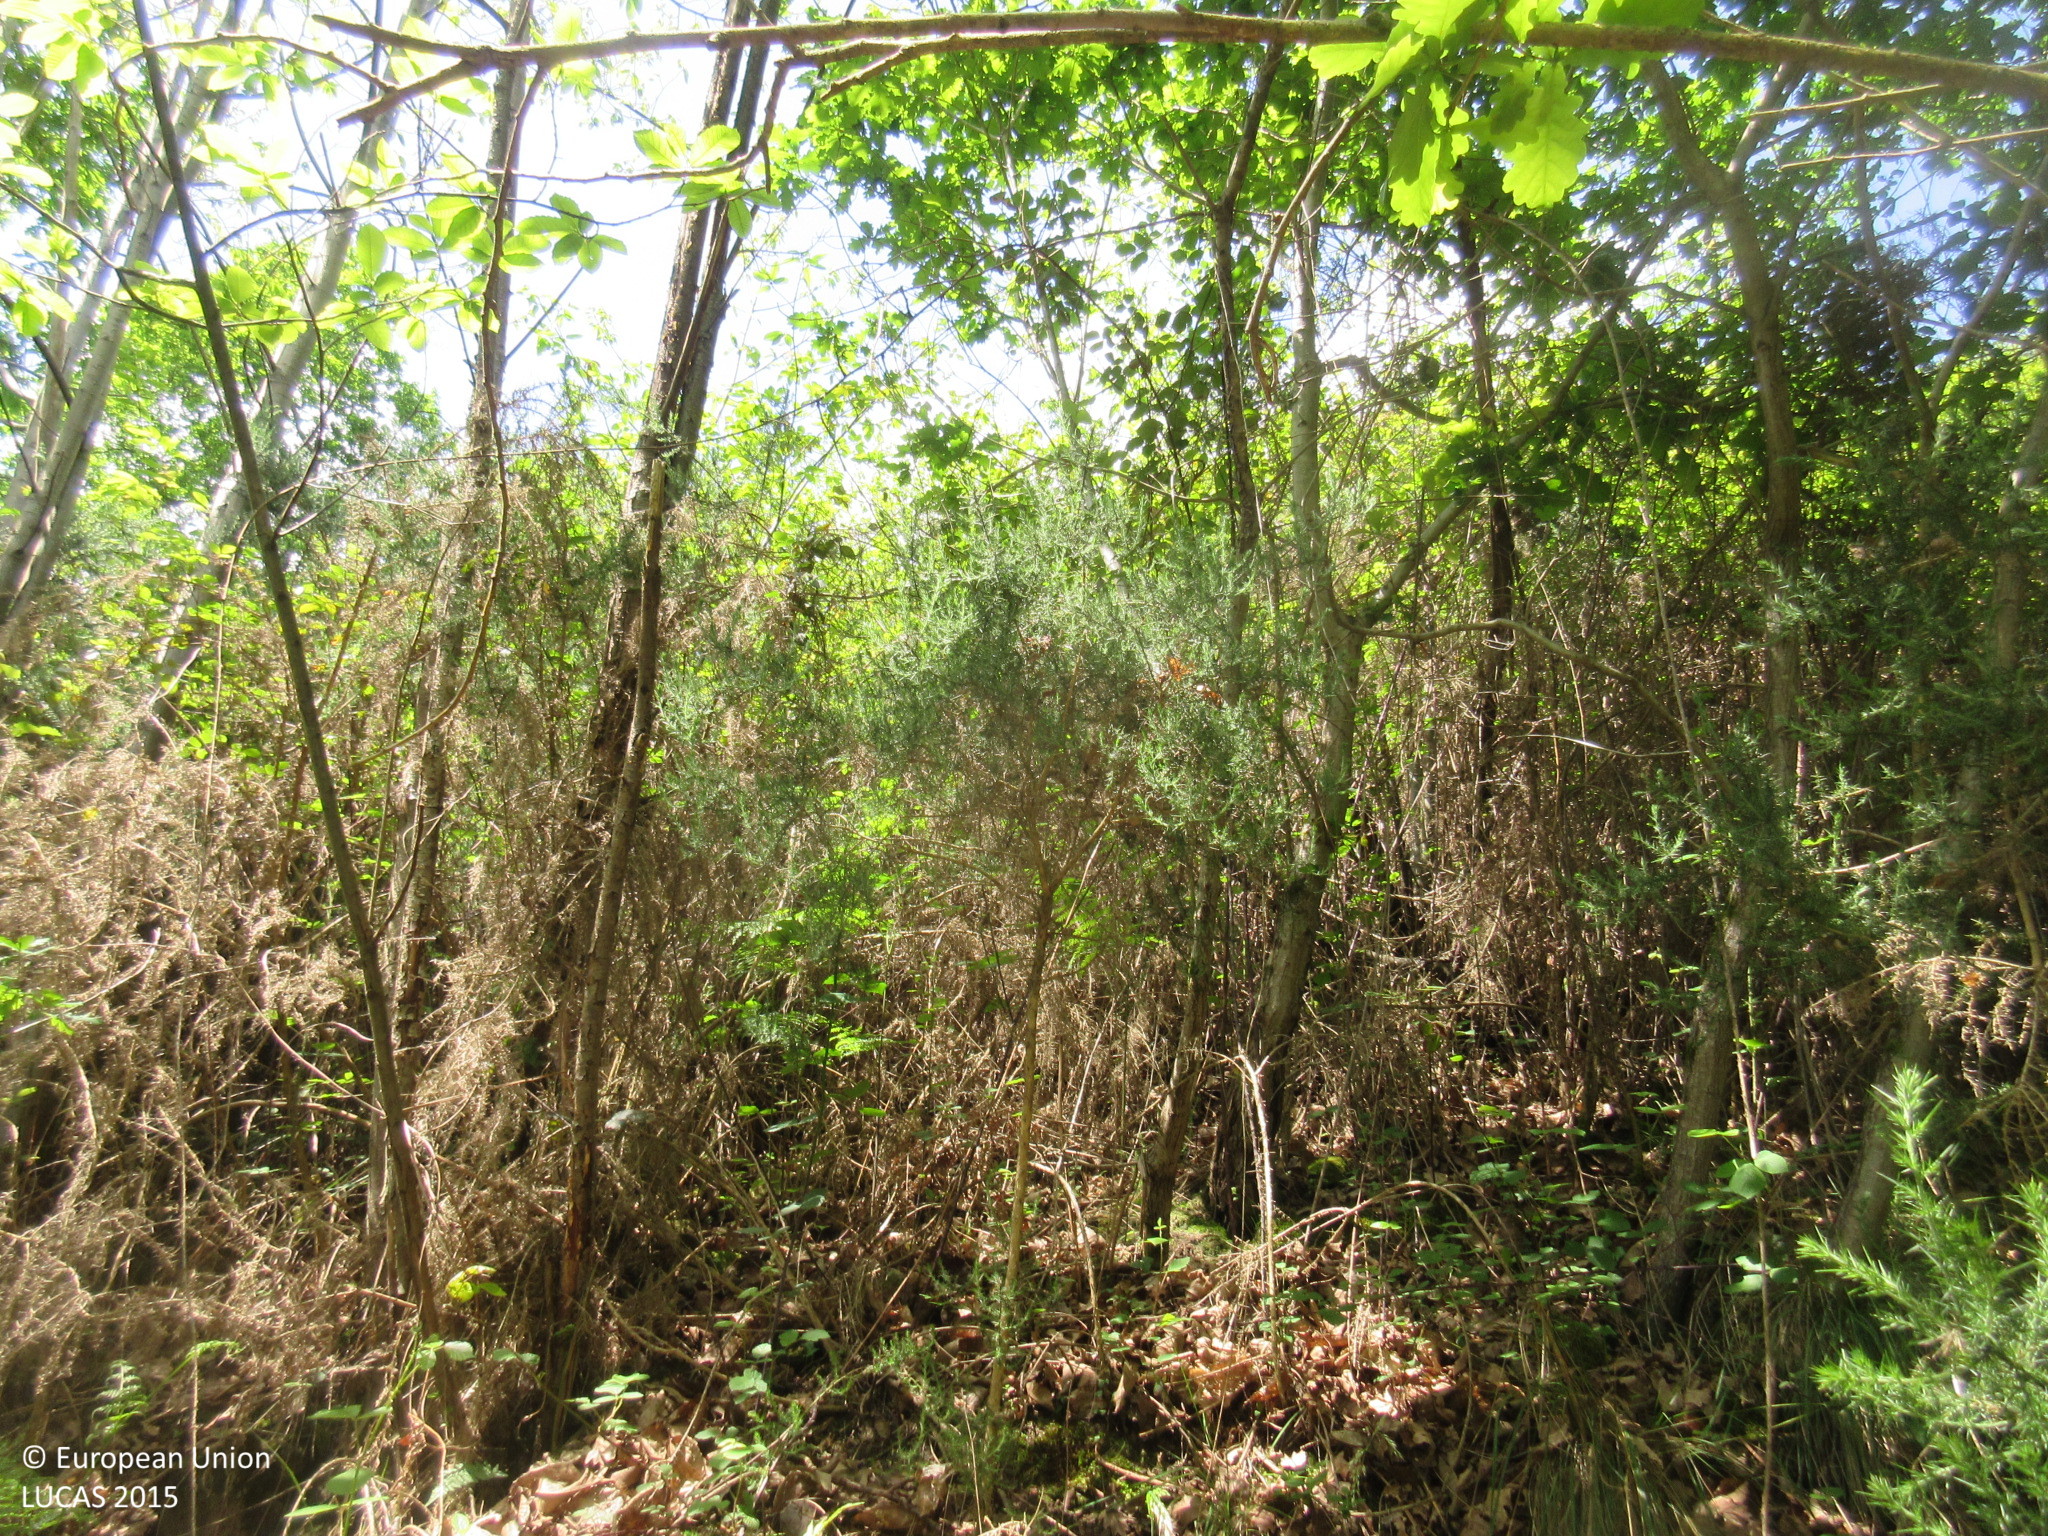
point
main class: Woodland
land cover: Broadleaved woodland
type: acidophilous oak and oak-birch forest
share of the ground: > 75 %
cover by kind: broadleaved forest trees 95 %, shrubs 5 %
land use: Forestry
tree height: > 5 m
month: May
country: ES
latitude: 43.3158
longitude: -5.9080
